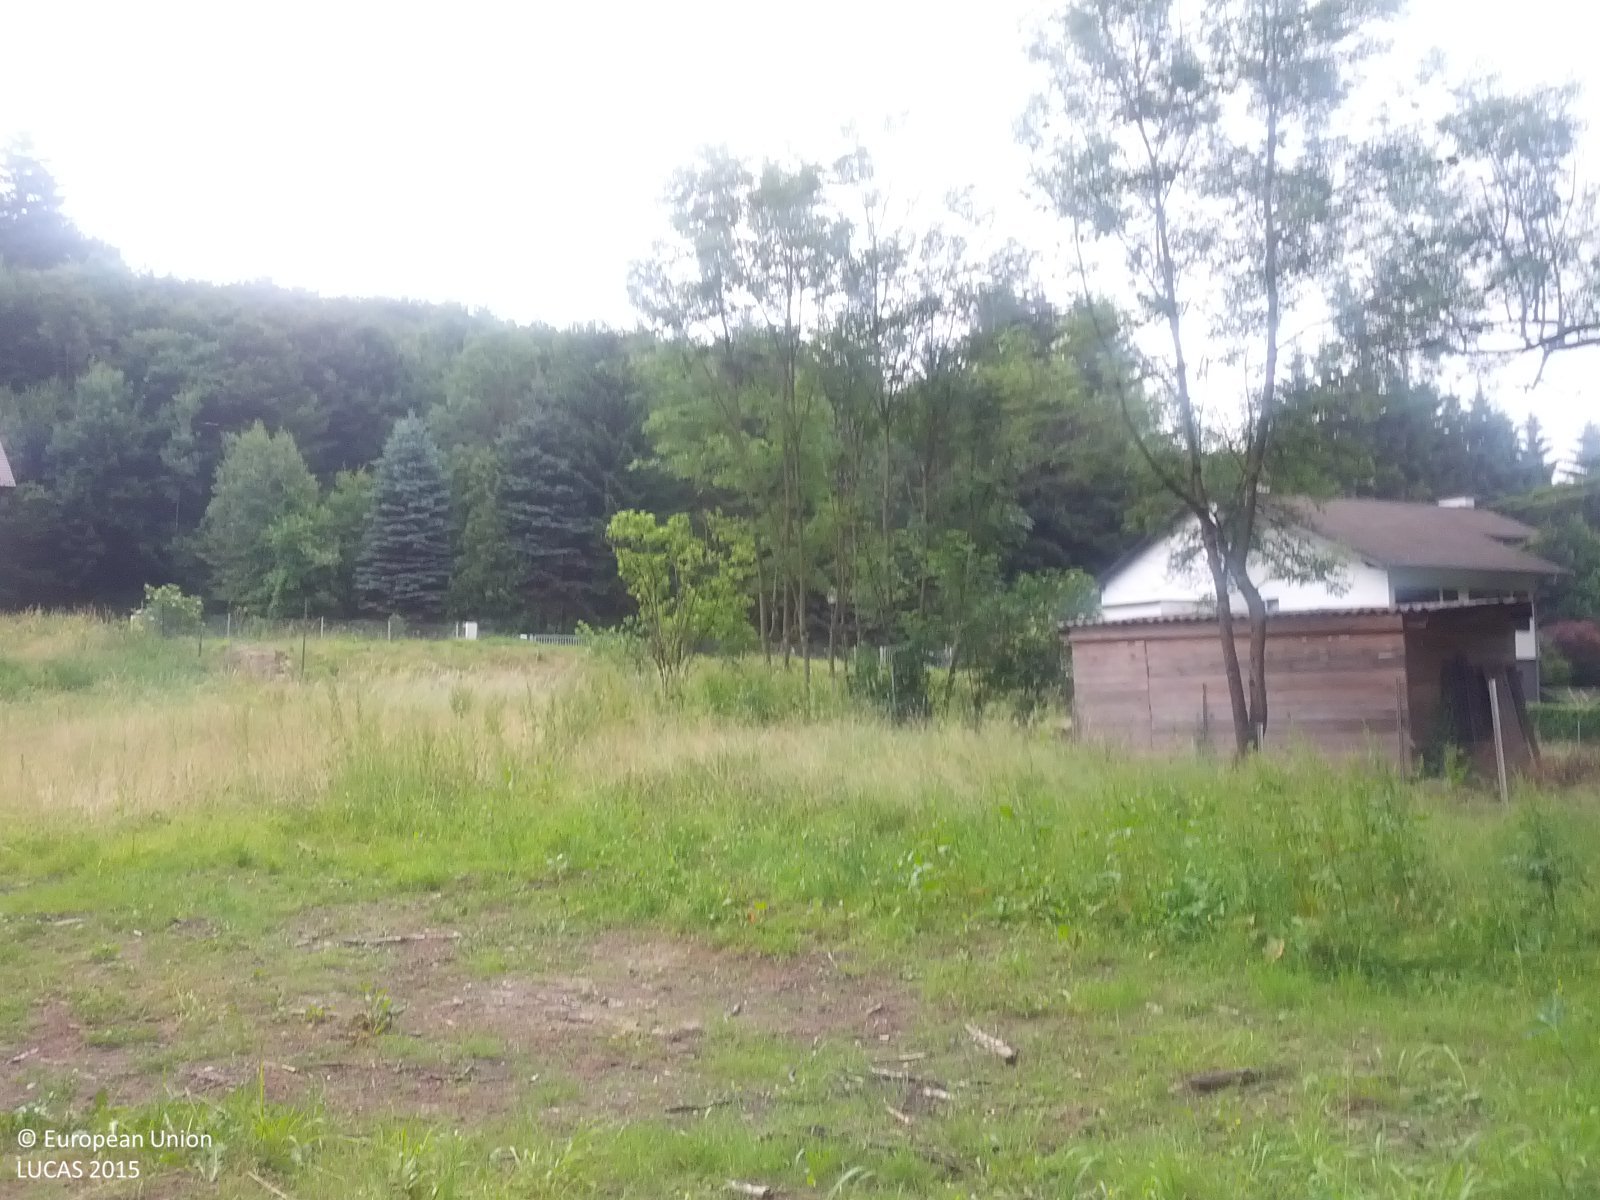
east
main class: Woodland
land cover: Spruce dominated mixed woodland
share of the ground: > 75 %
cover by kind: unconsolidated bare surface 50 %, herbaceous plants 25 %, coniferous forest trees 10 %, broadleaved forest trees 10 %, shrubs 5 %
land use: Forestry
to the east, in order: Spruce dominated mixed woodland; Grassland without tree/shrub cover; Artificial constructions in urban areas; Lines of trees; Fences; Grassland without tree/shrub cover; Broadleaved woodland; Grass margins; Paved roads, cycling and walking lanes; Broadleaved woodland; Spruce dominated mixed woodland
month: June
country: AT
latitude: 48.2005
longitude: 16.0720
